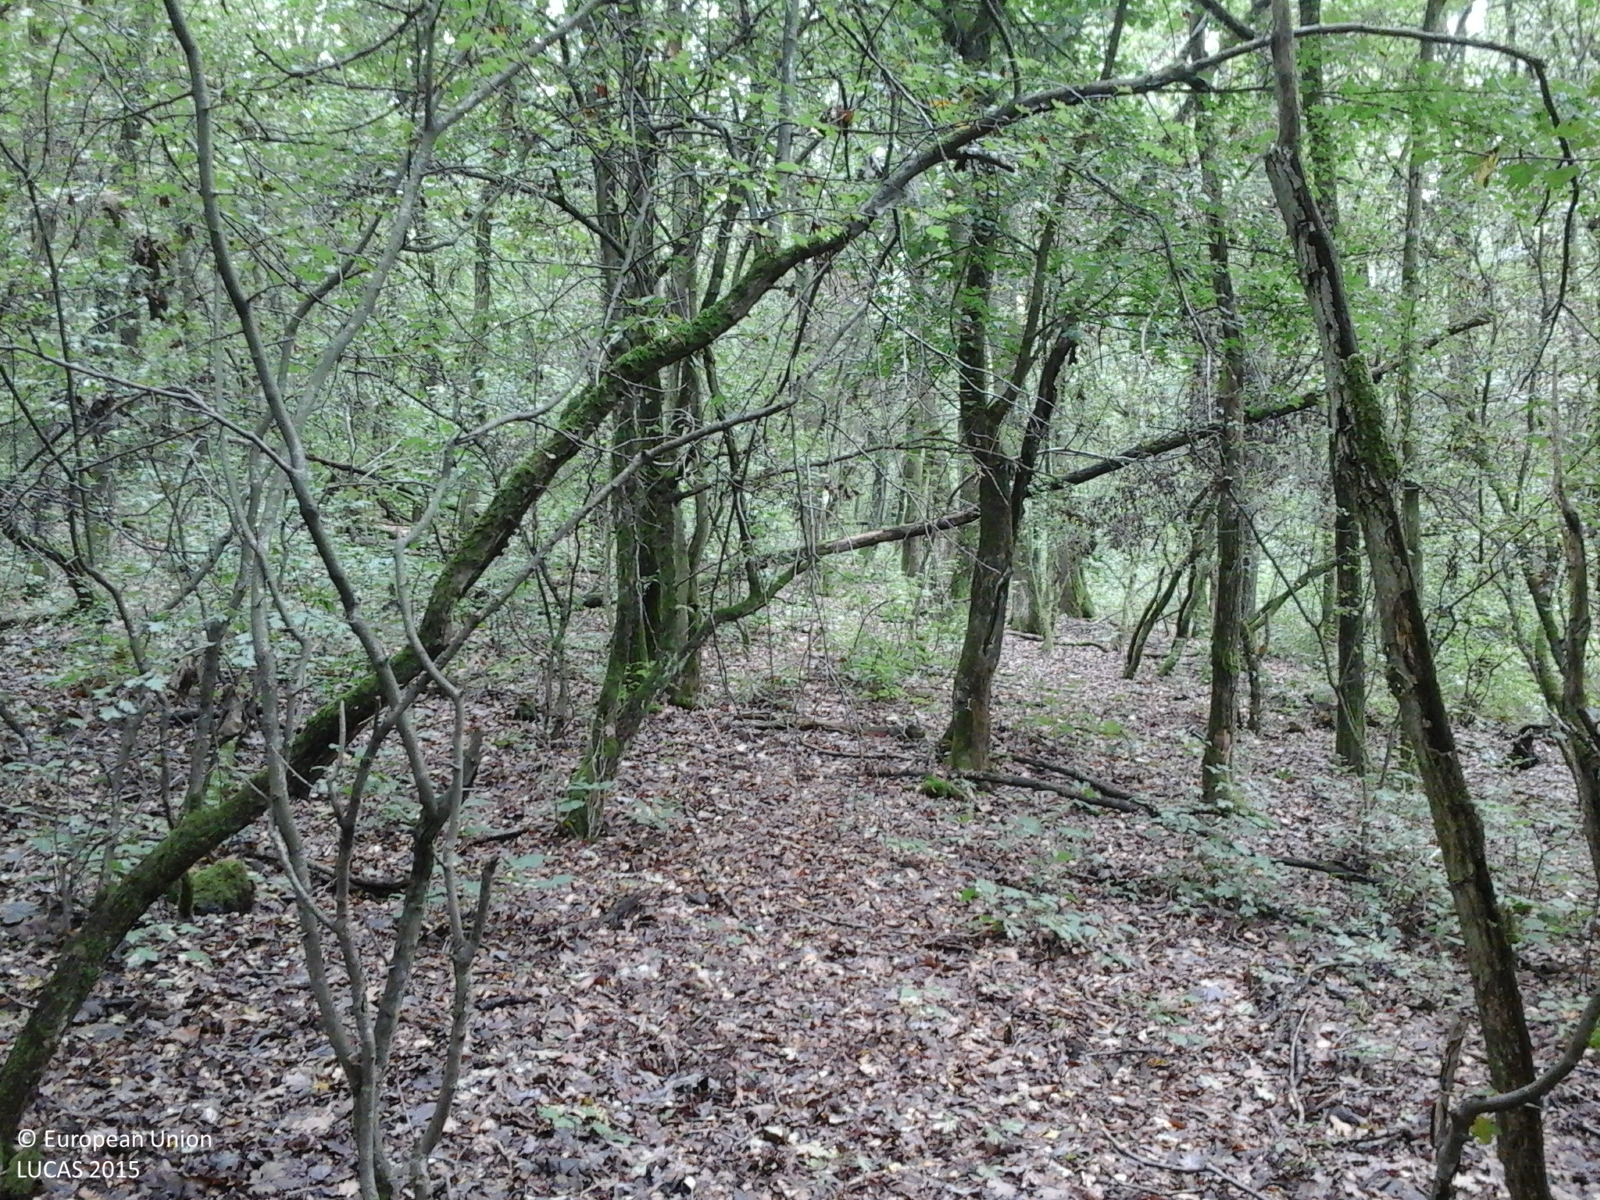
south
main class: Woodland
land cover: Broadleaved woodland
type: acidophilous oak and oak-birch forest
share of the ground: > 75 %
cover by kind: broadleaved forest trees 100 %
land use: Forestry
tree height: > 5 m
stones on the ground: < 10 %
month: August
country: RO
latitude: 45.9999
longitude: 21.5144
